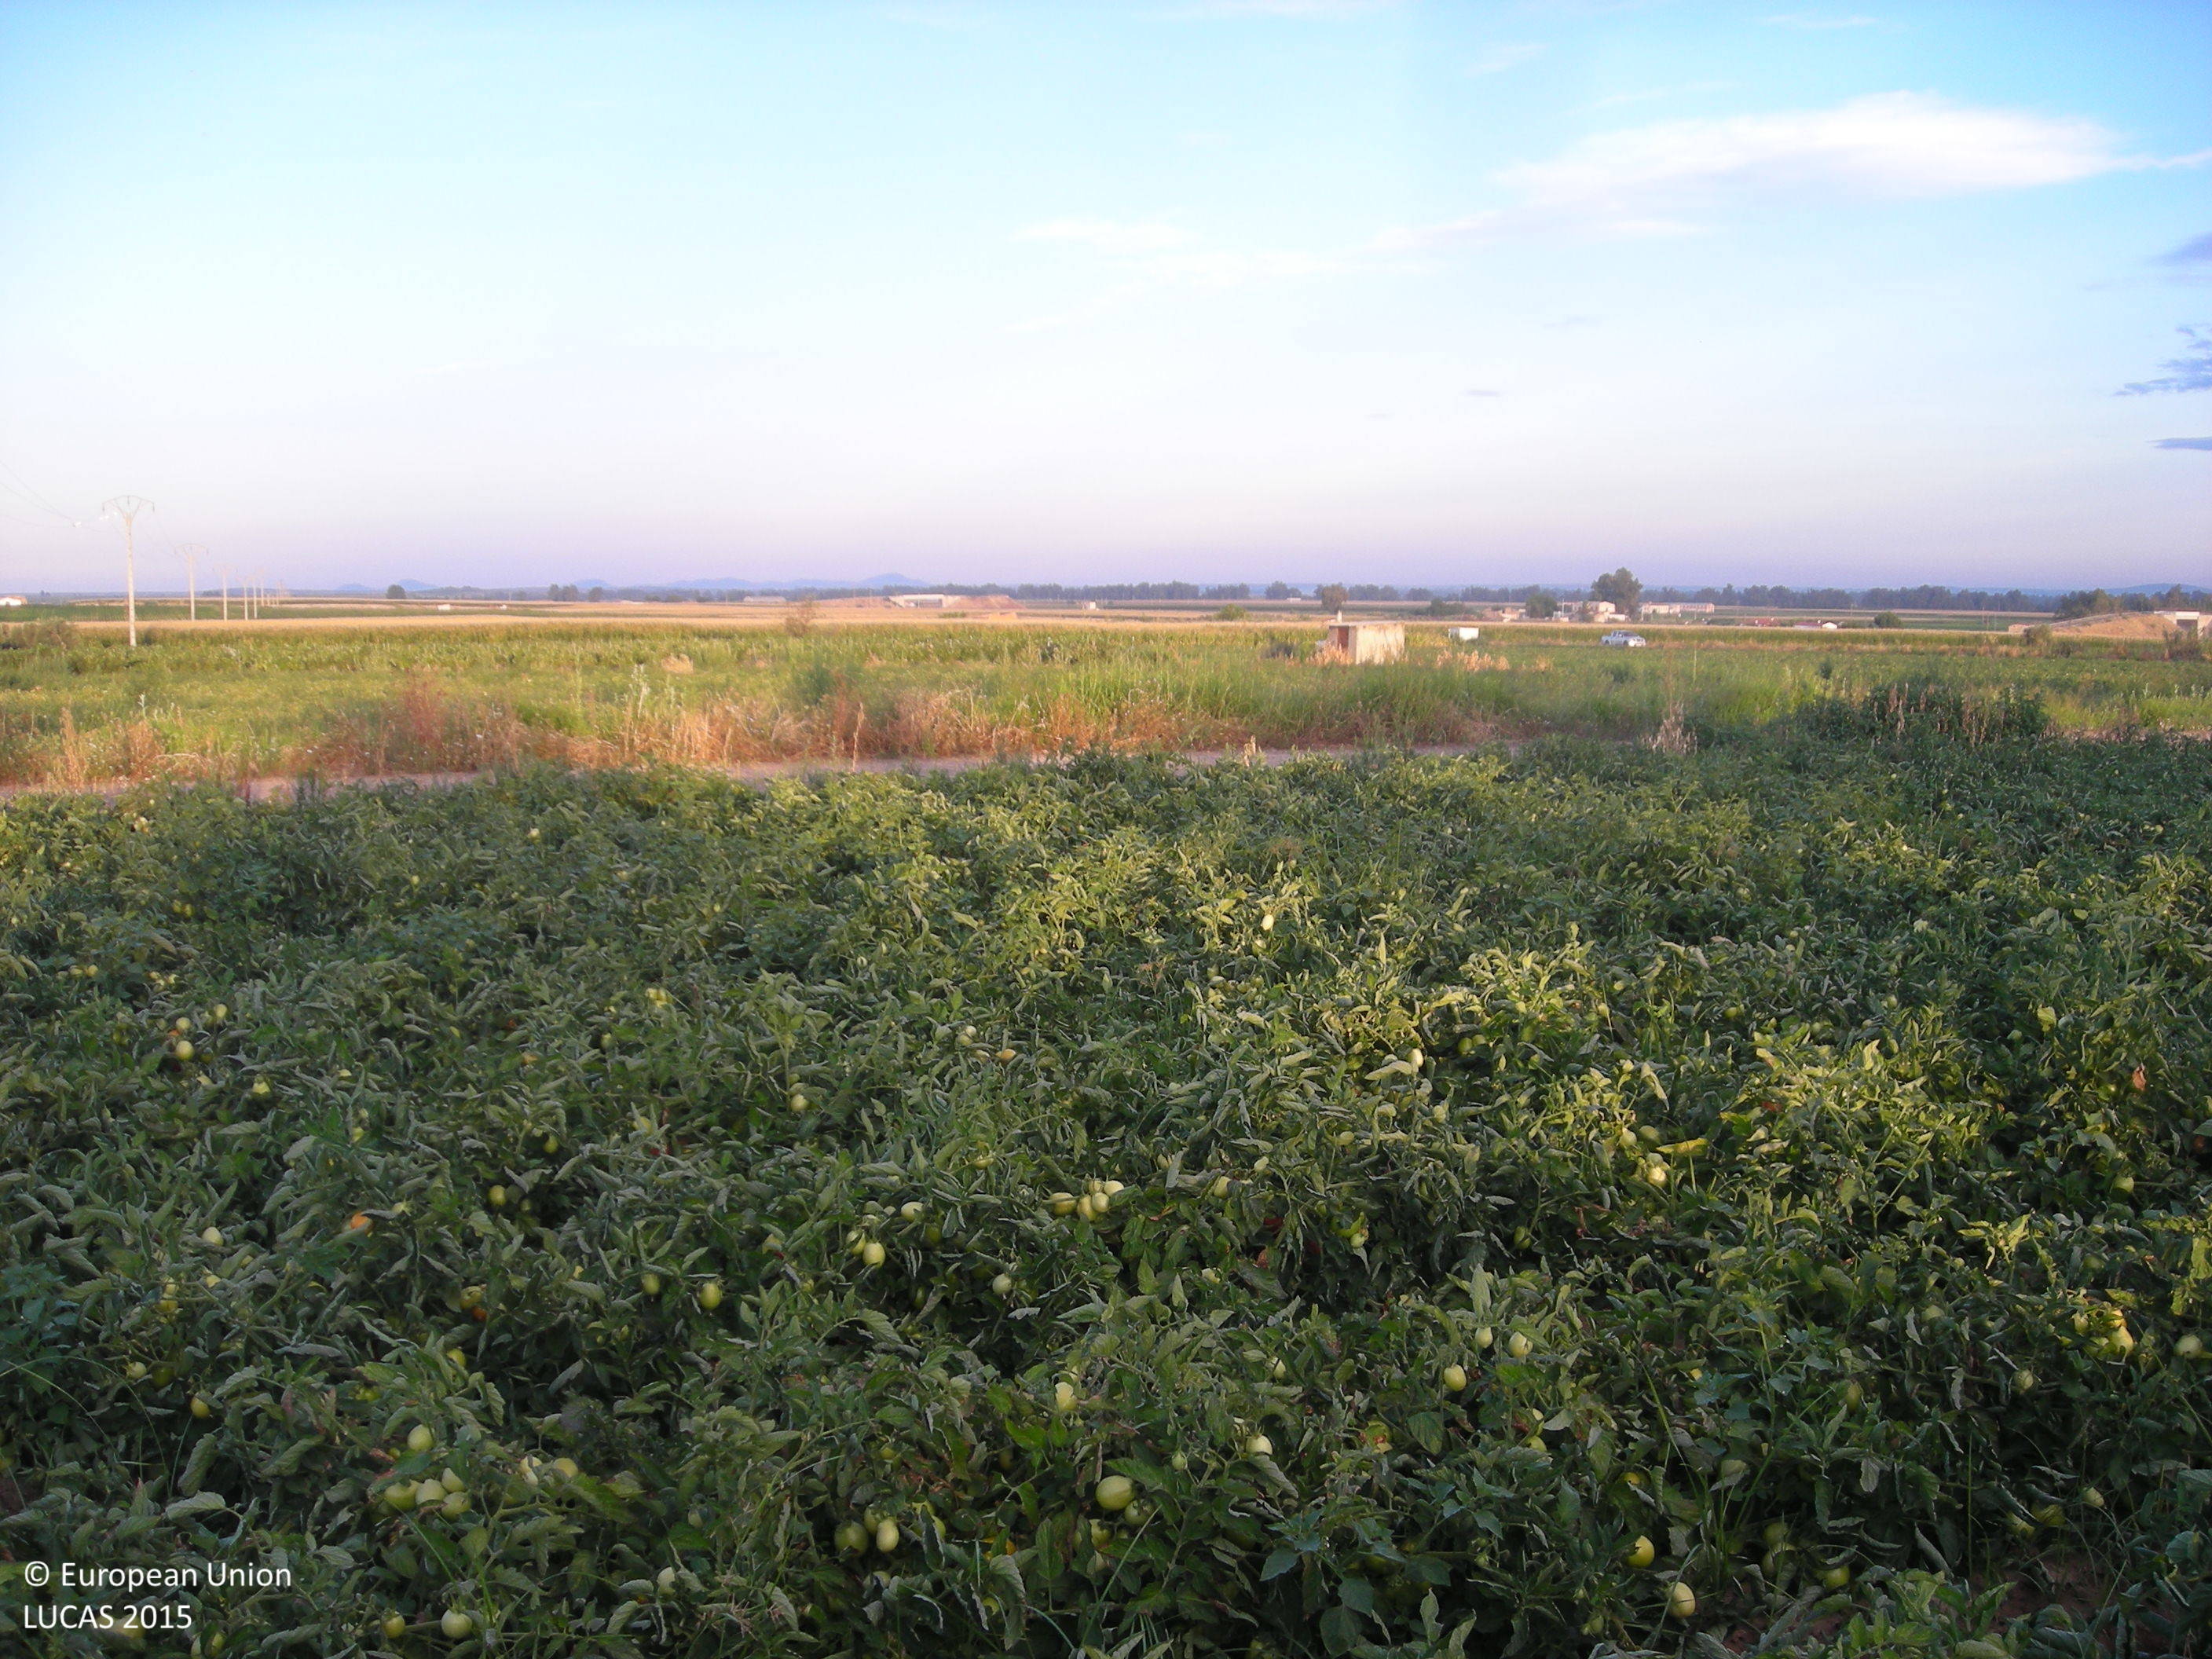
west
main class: Cropland
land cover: Tomatoes
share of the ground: > 75 %
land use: Agriculture (excluding fallow land and kitchen gardens)
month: July
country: ES
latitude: 38.9331
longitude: -5.9586
